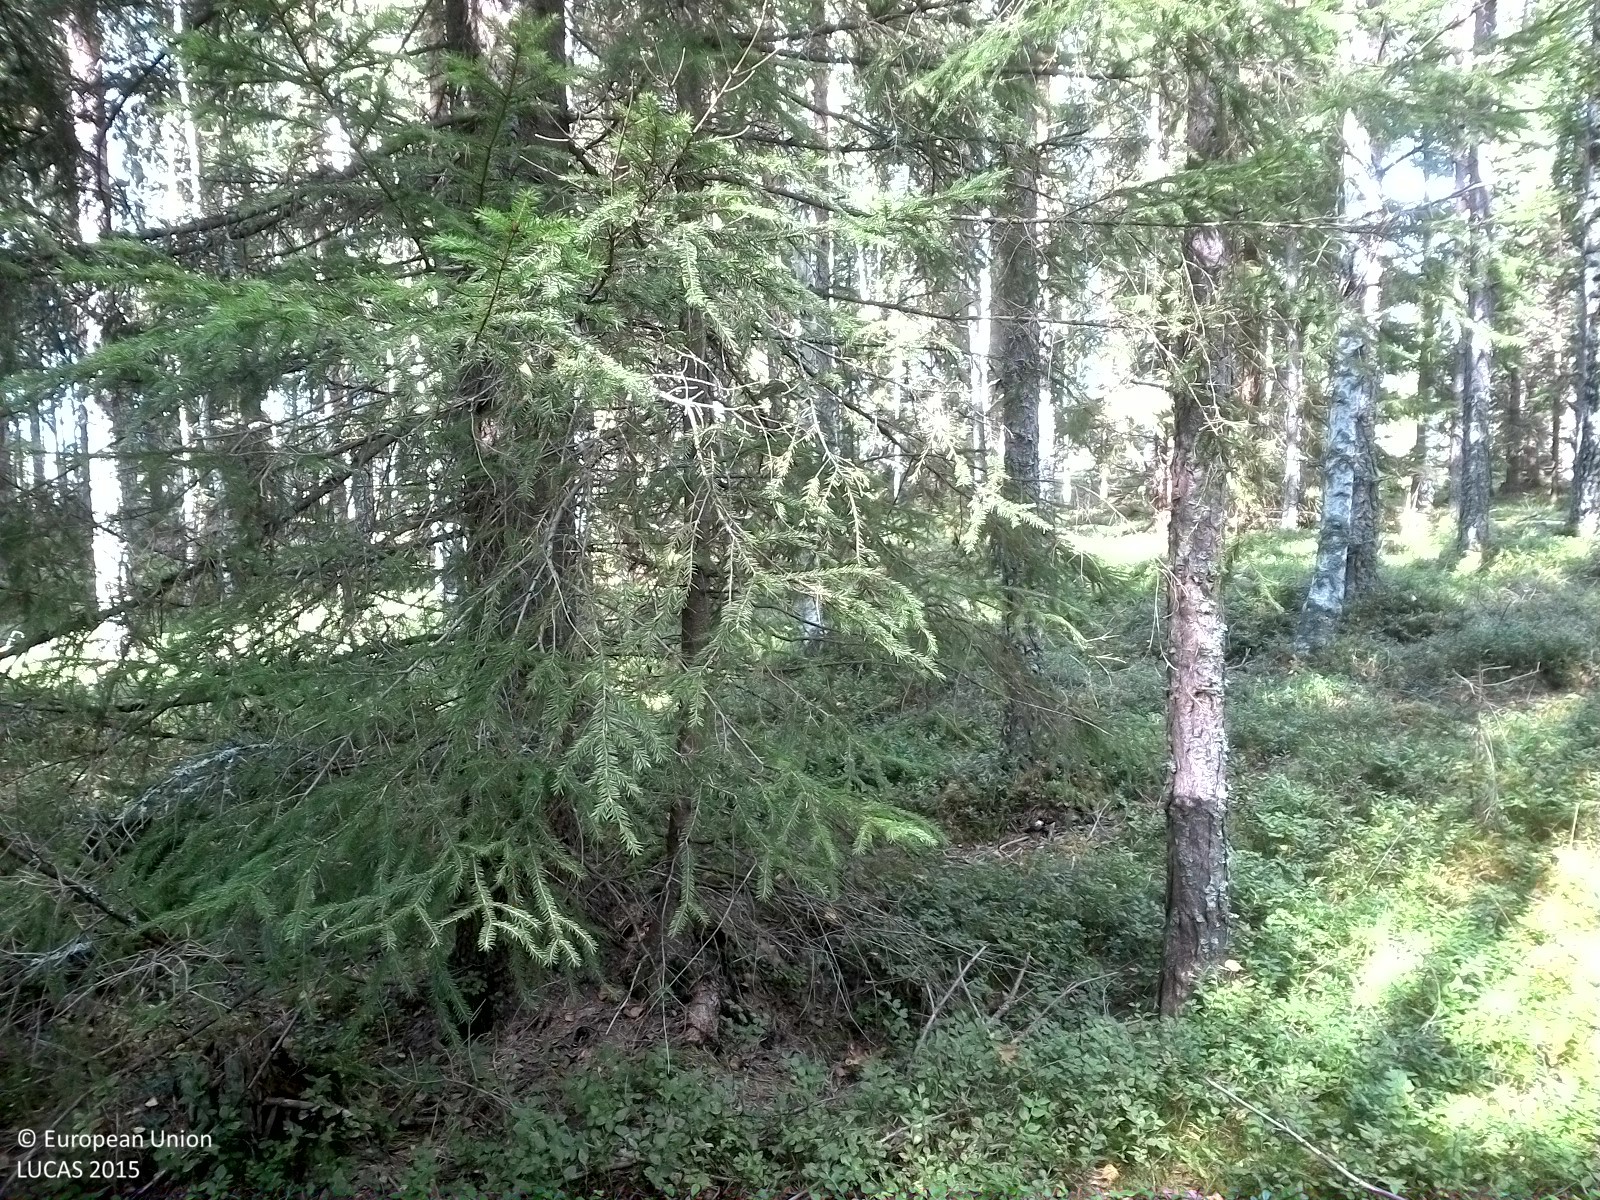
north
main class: Woodland
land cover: Other mixed woodland
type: boreal forest
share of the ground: 25 - 50 %
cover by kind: herbaceous plants 40 %, coniferous forest trees 30 %, broadleaved forest trees 15 %, lichens and mosses 15 %
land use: Forestry
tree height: > 5 m
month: August
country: SE
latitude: 59.0235
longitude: 15.5843
